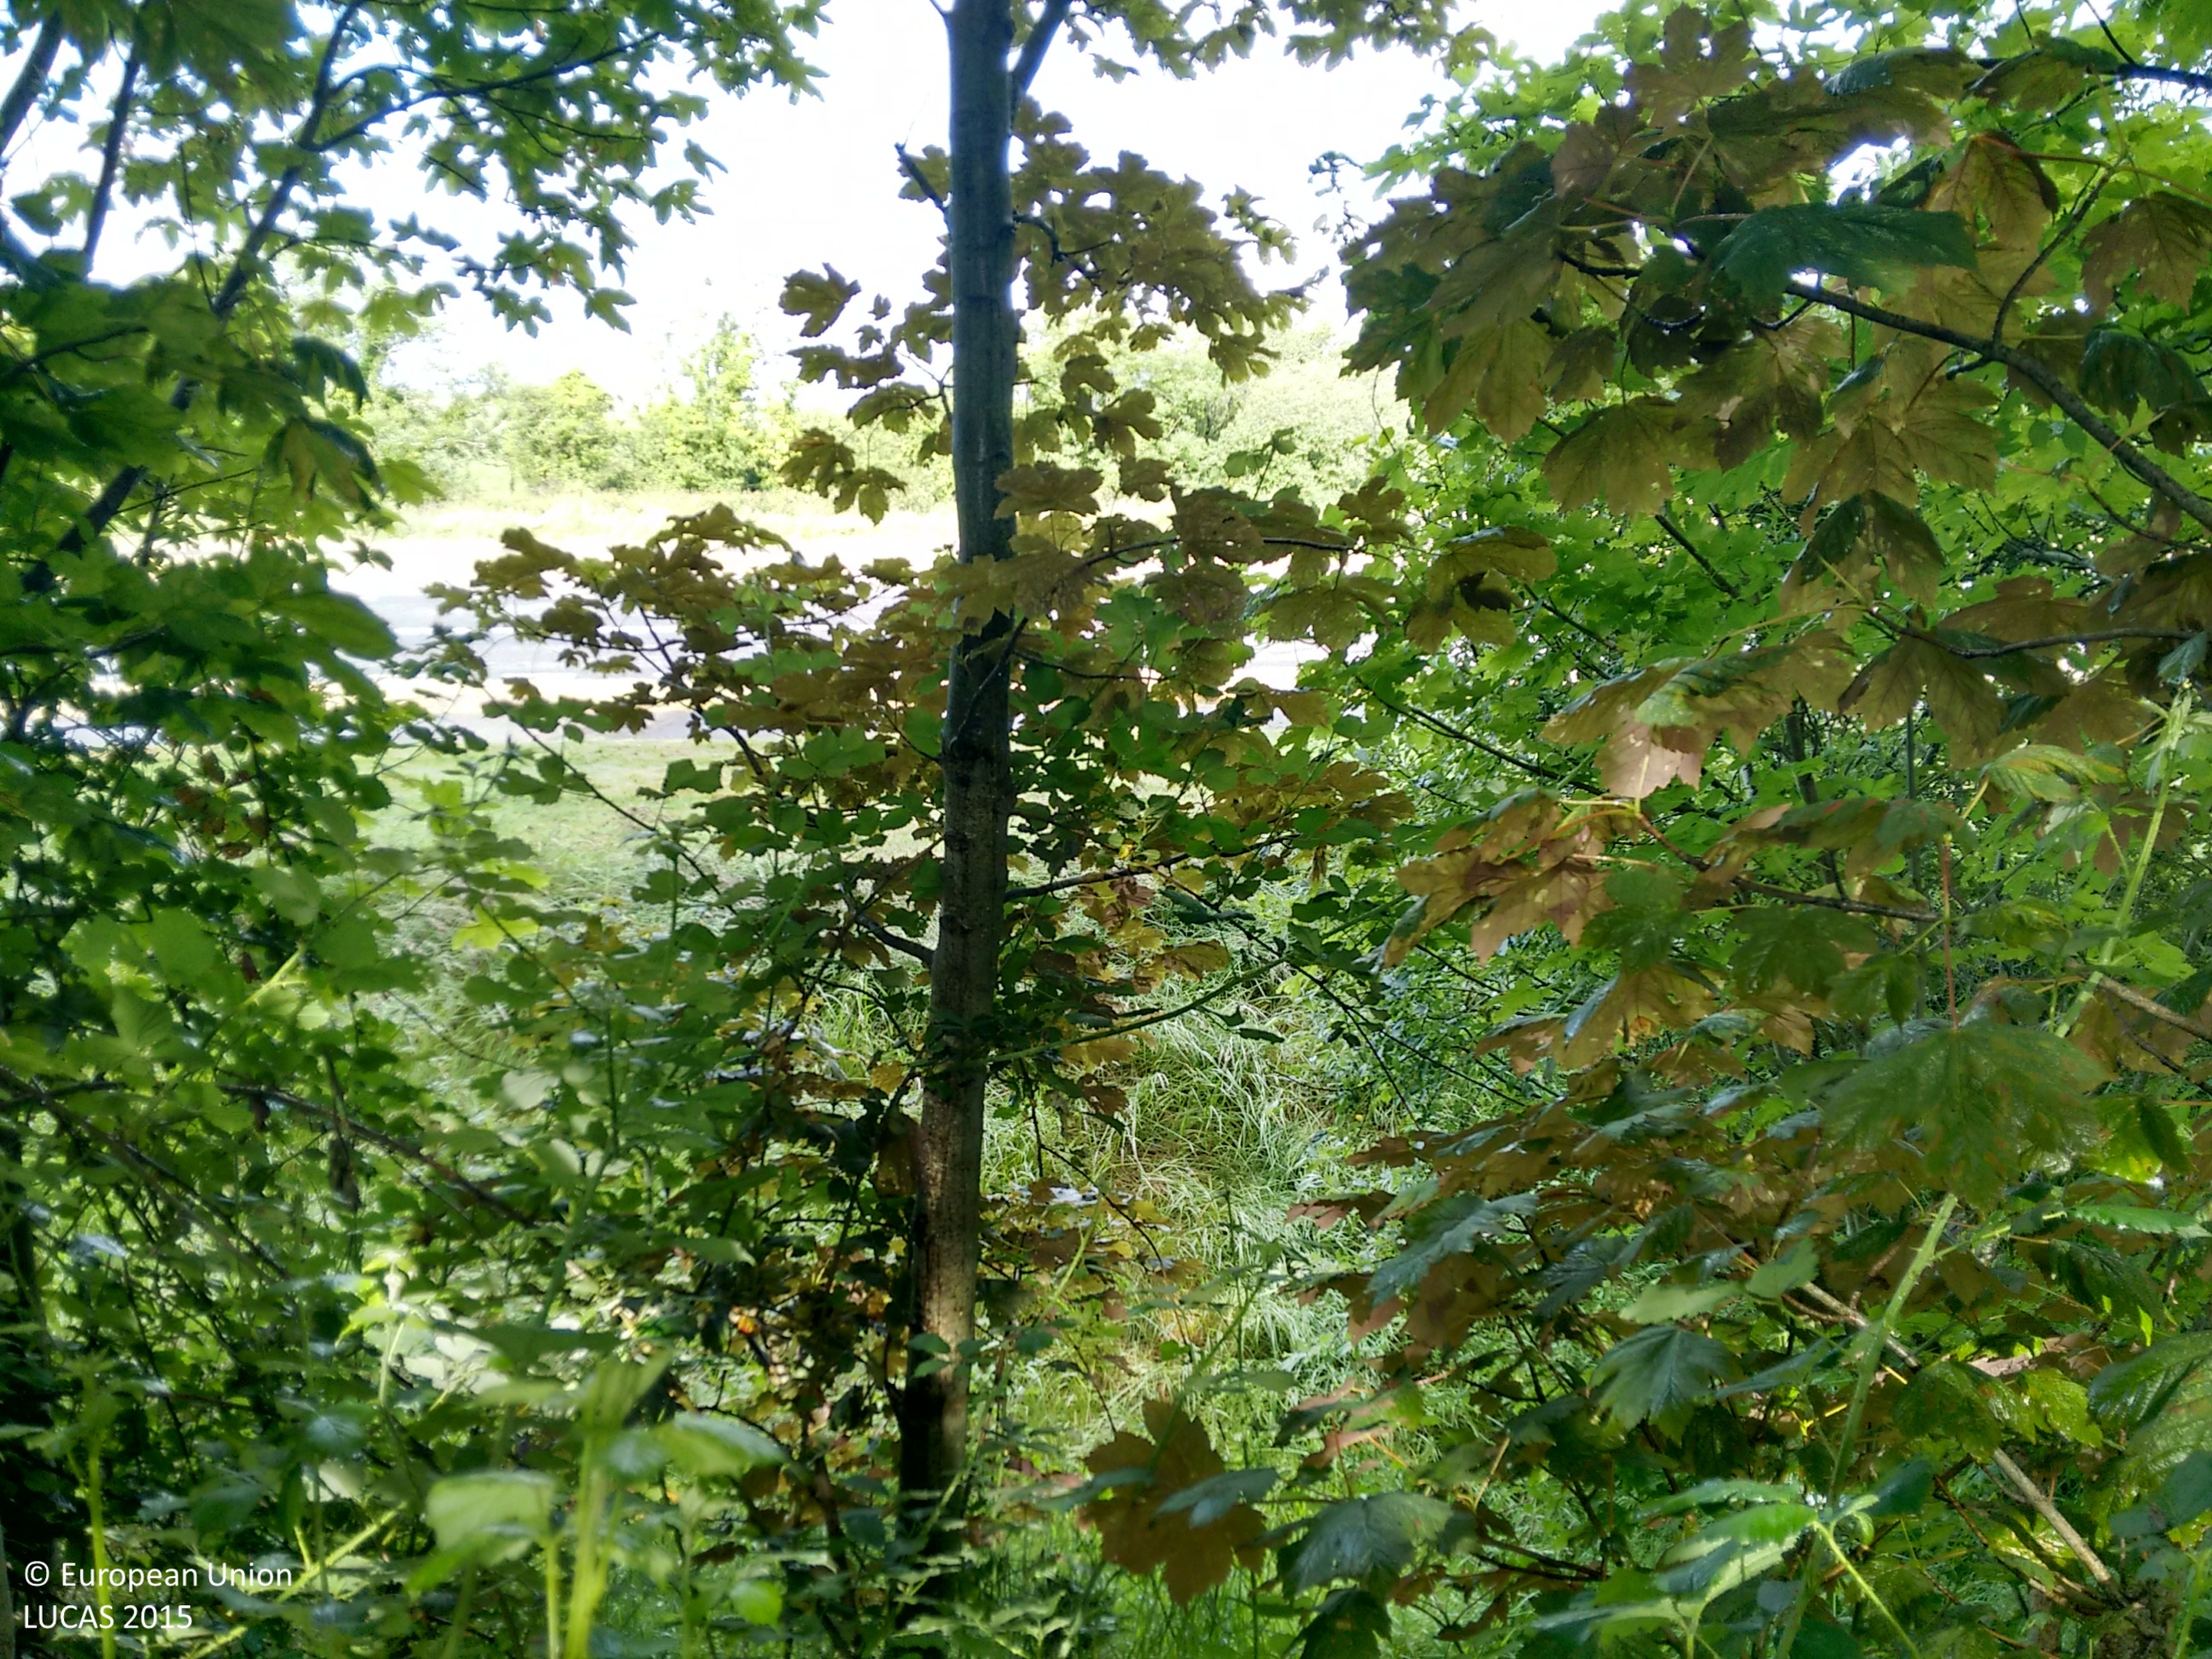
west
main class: Woodland
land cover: Broadleaved woodland
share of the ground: > 75 %
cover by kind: broadleaved forest trees 95 %, herbaceous plants 5 %
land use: Semi-natural and natural areas not in use
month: June
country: IE
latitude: 52.2558
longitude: -7.1562
